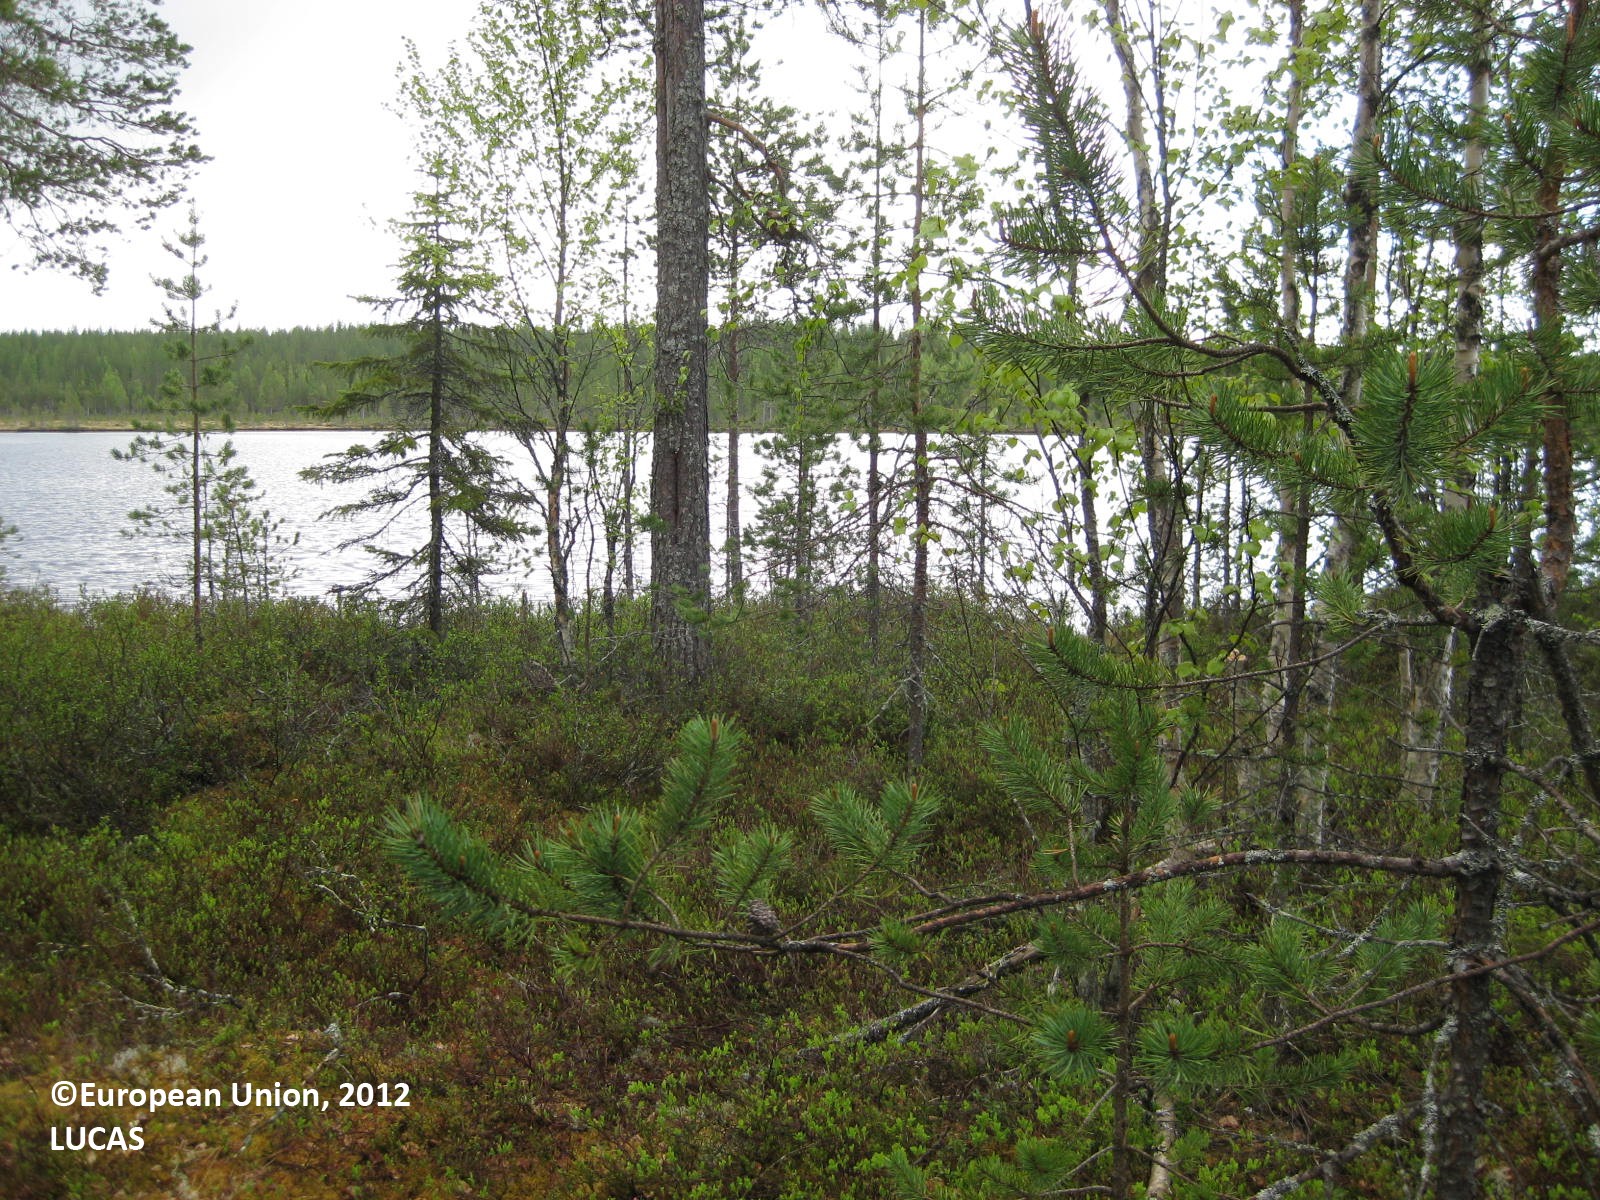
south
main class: Woodland
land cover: Pine dominated mixed woodland
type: boreal forest
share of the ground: 50 - 75 %
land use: Forestry
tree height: > 5 m
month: June
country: FI
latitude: 65.1745
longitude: 29.6557
